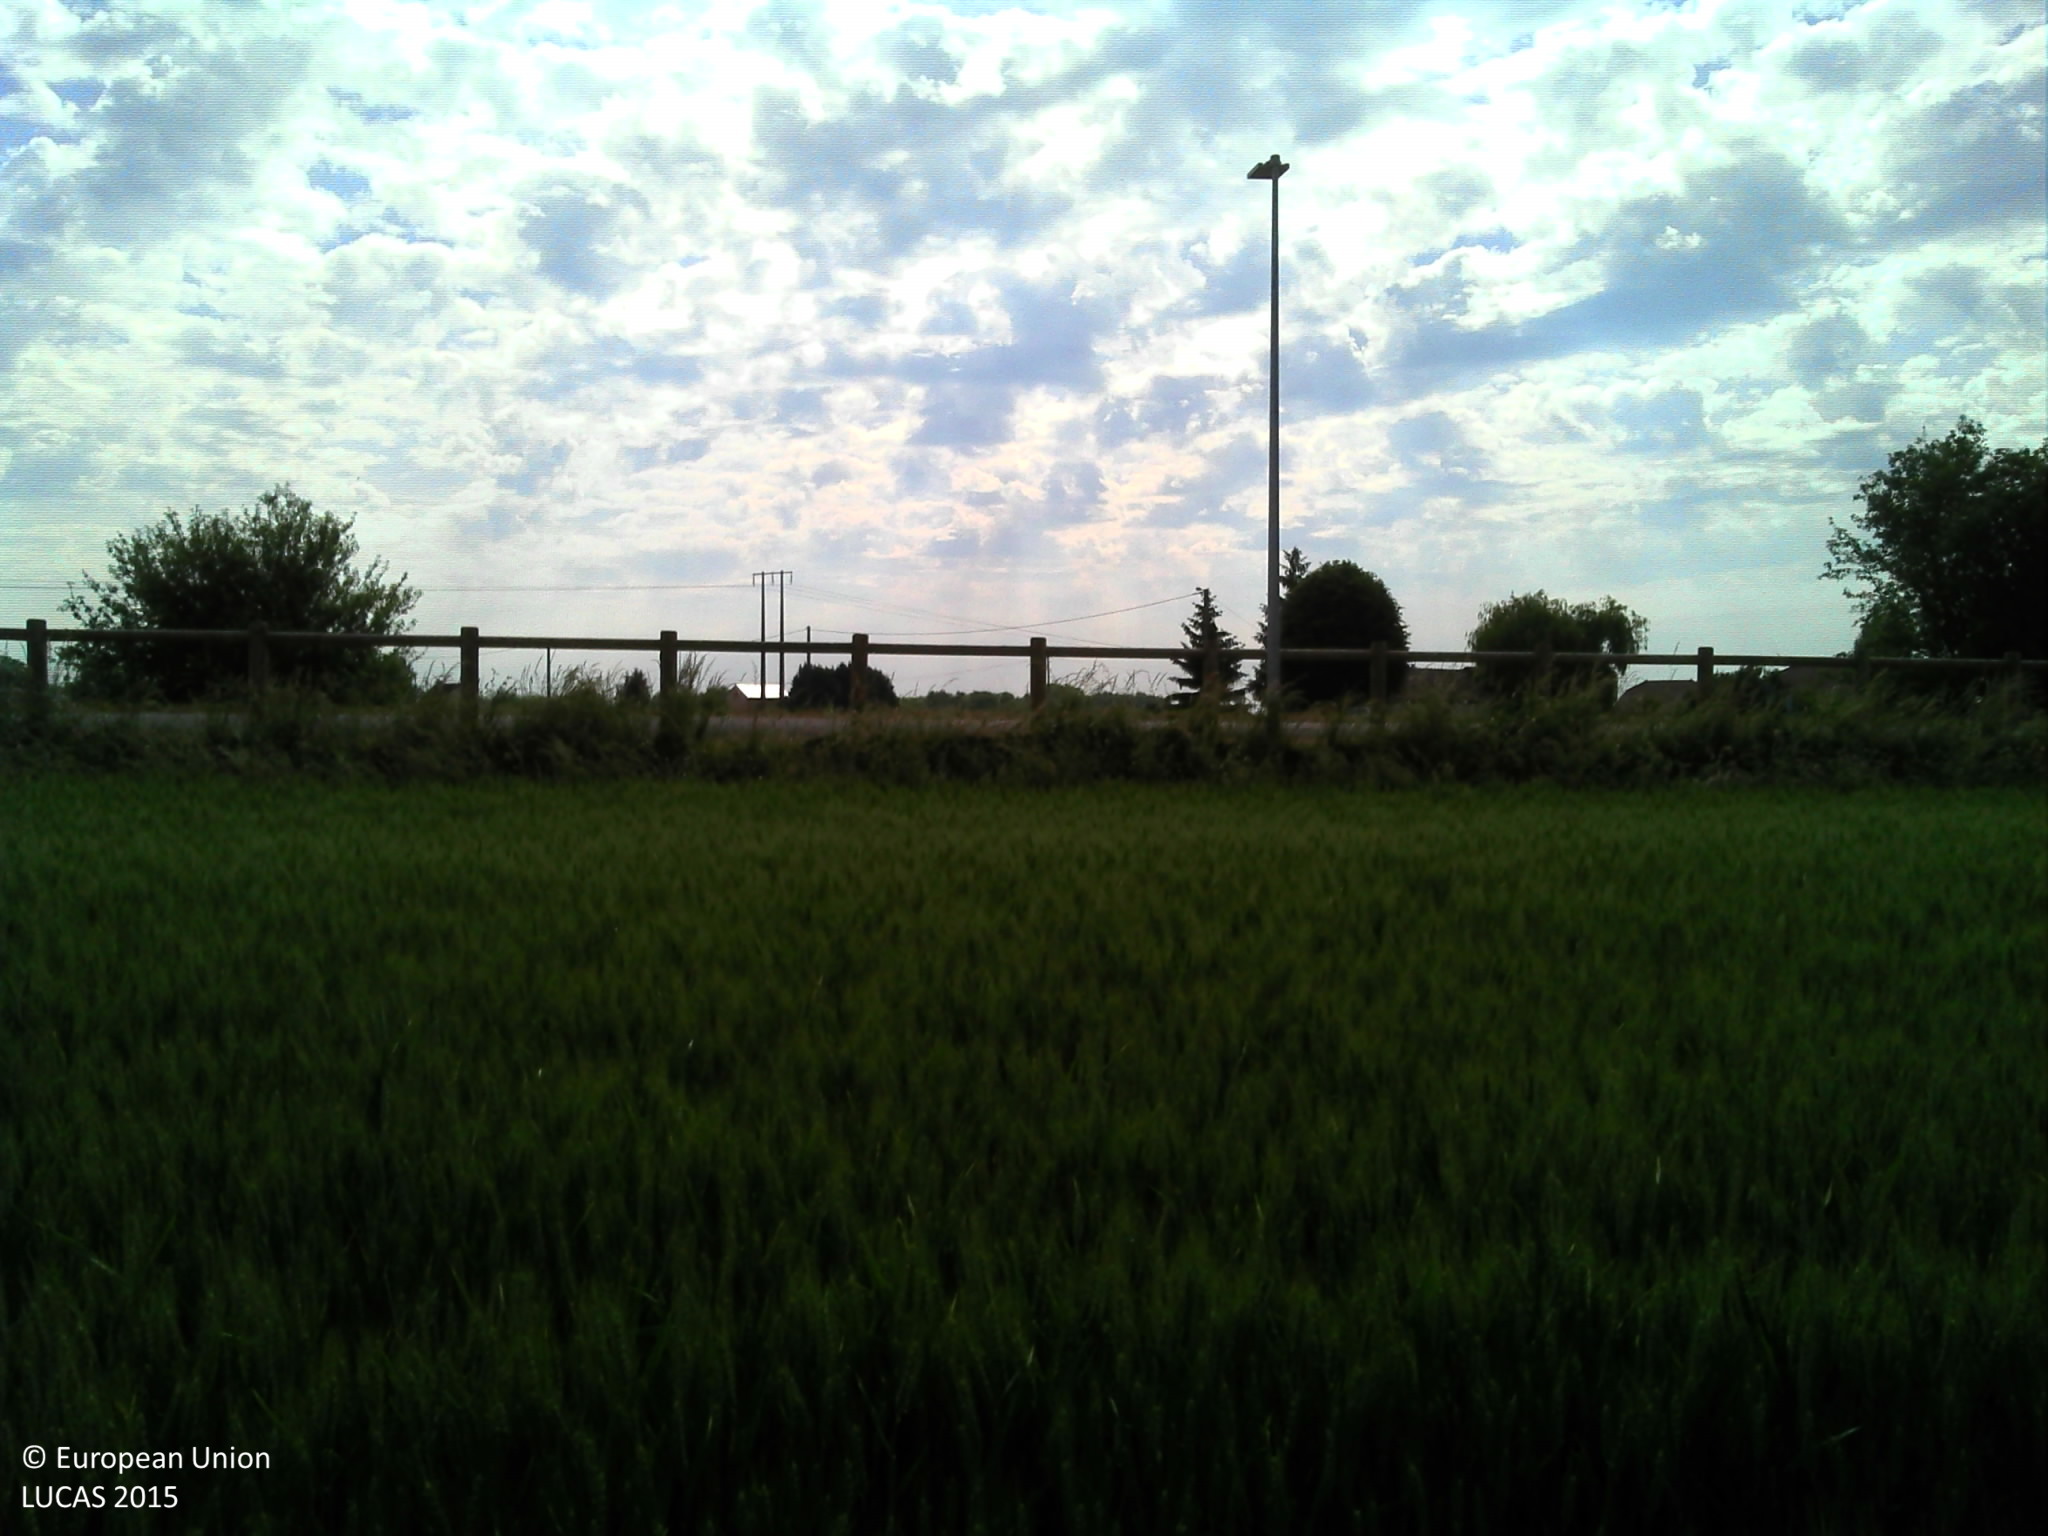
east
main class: Cropland
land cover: Common wheat
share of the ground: > 75 %
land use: Agriculture (excluding fallow land and kitchen gardens)
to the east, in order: Common wheat; Grass margins; Tracks; Fences; Paved roads, cycling and walking lanes; Grass margins; Grassland with sparse tree/shrub cover; Common wheat; Grassland without tree/shrub cover; Paved roads, cycling and walking lanes; Grassland without tree/shrub cover; Electric lines; Sunflower; Electric lines; Common wheat
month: May
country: FR
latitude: 47.2202
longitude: 5.2603
